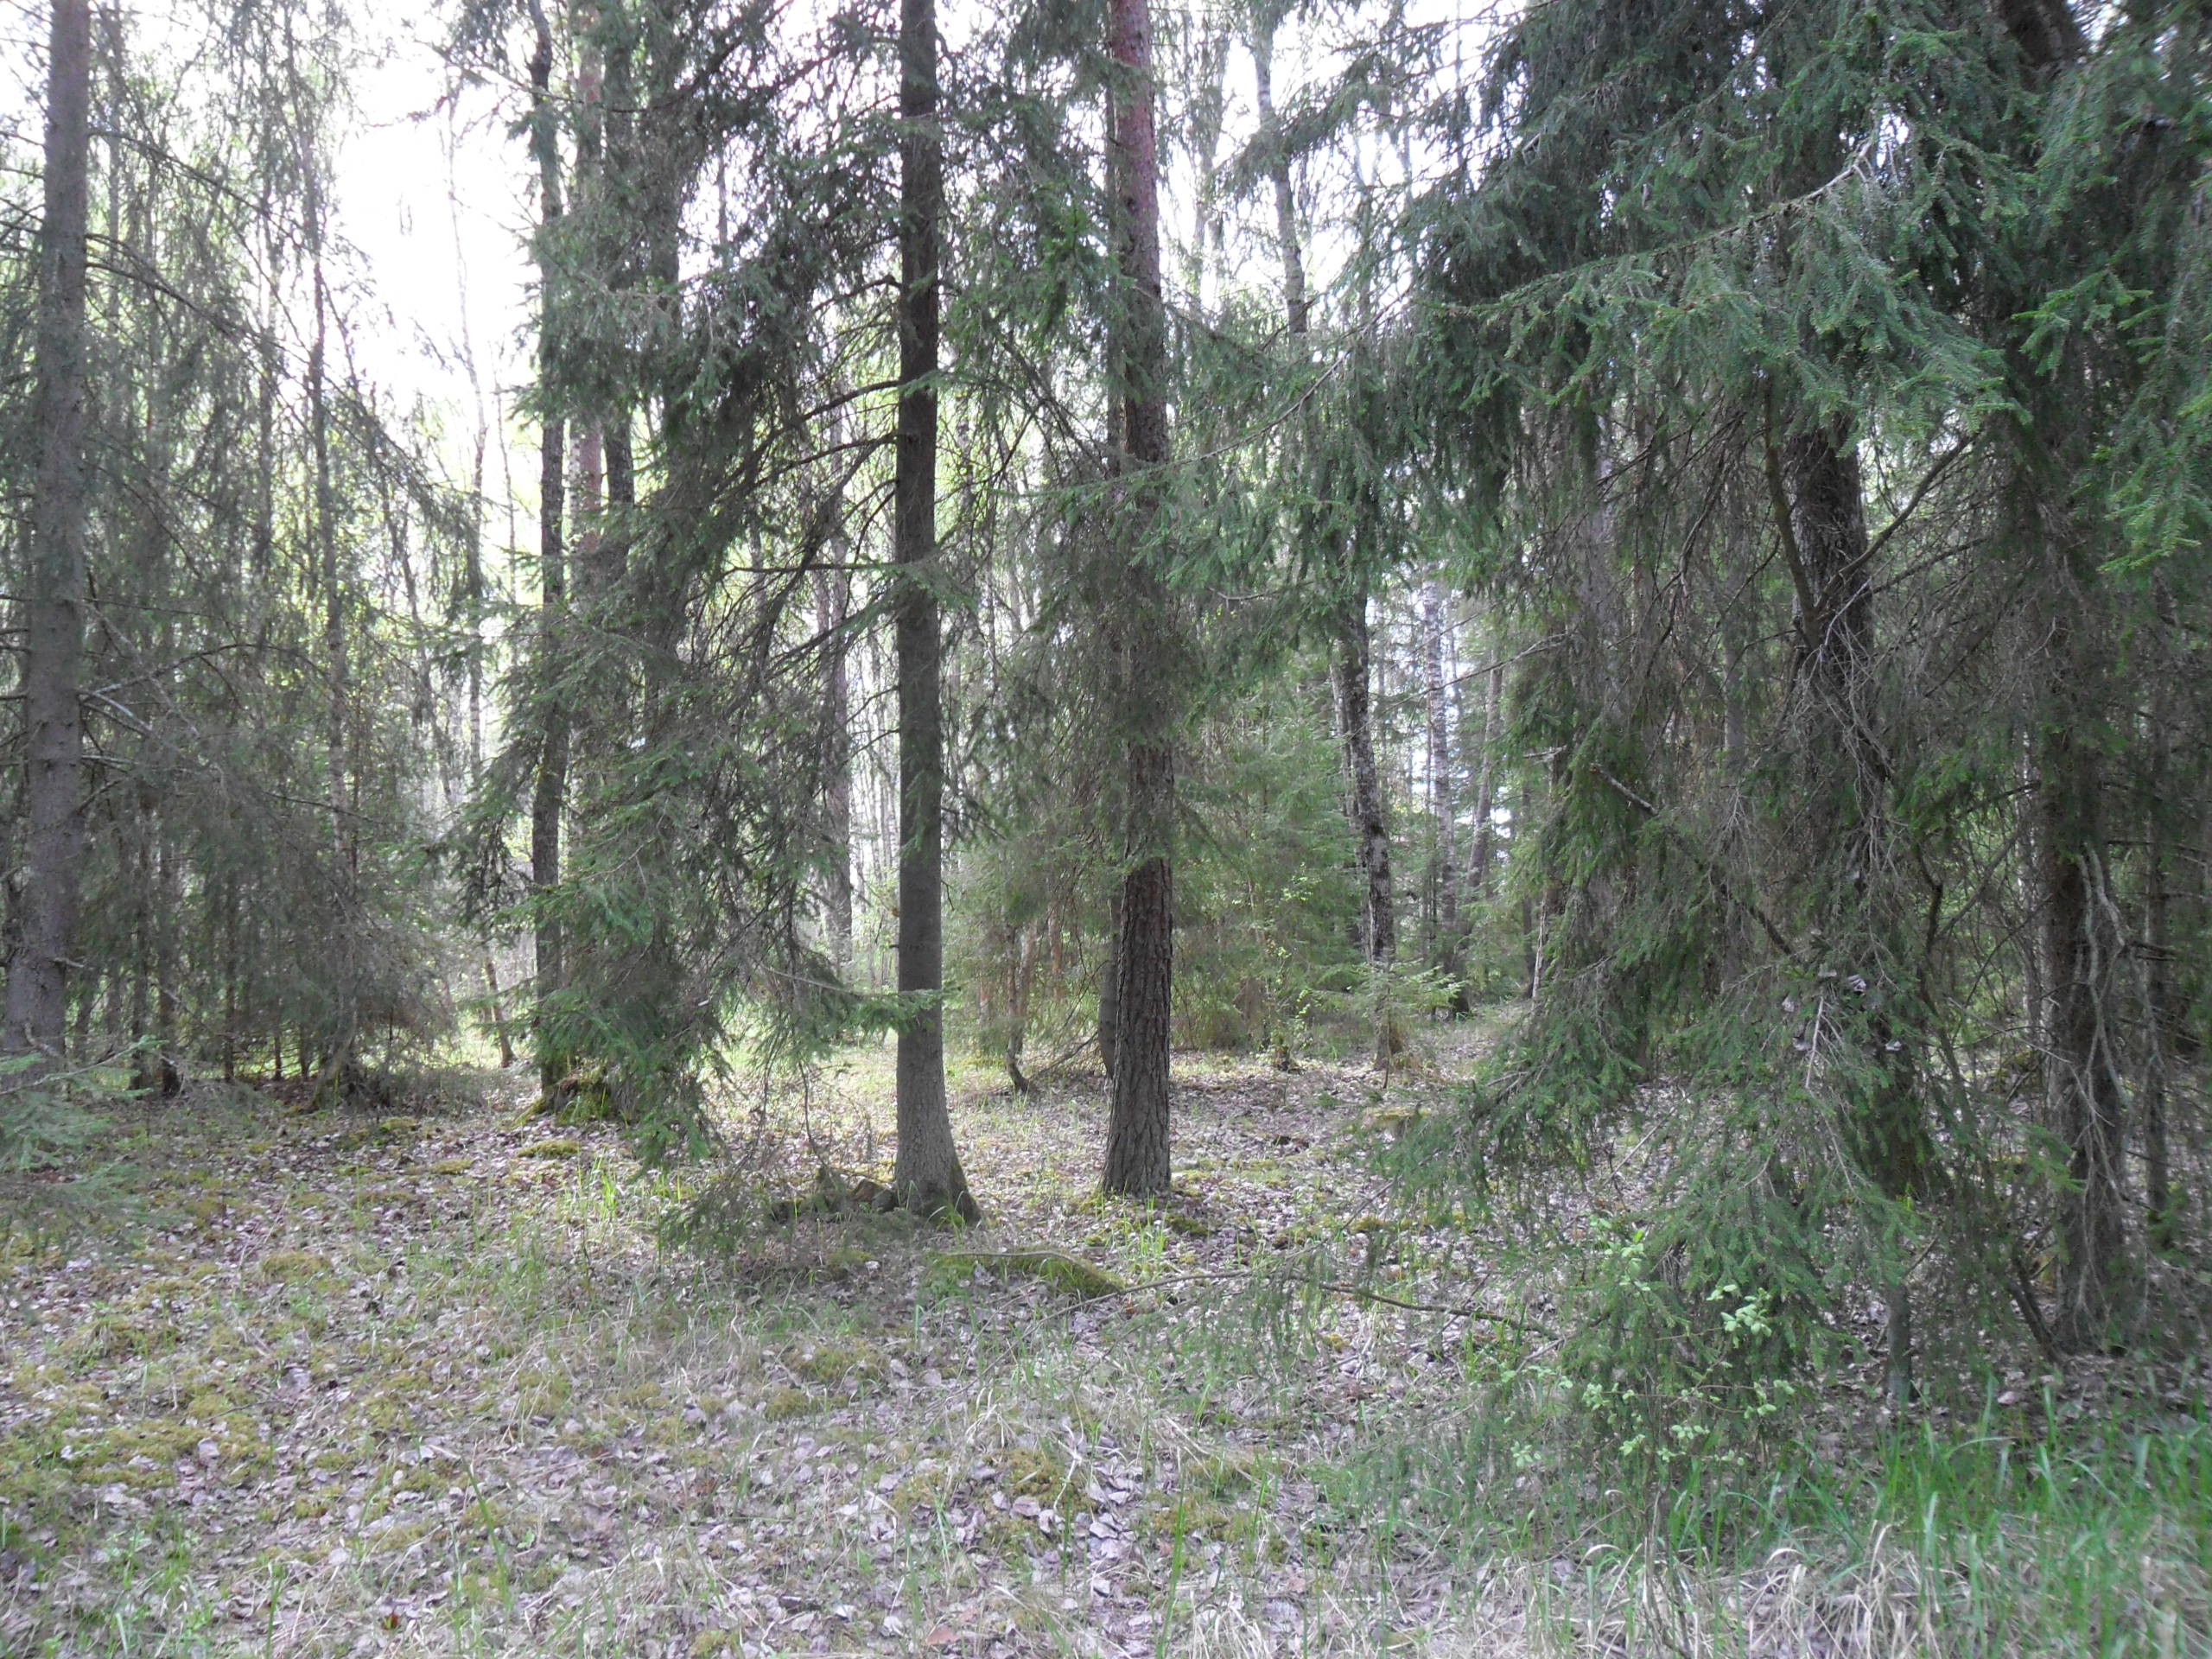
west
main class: Woodland
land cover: Spruce dominated mixed woodland
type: hemiboreal forest and nemoral coniferous forest and mixed broadleaved-coniferous forest
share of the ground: > 75 %
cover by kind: coniferous forest trees 55 %, broadleaved forest trees 45 %
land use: Forestry
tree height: > 5 m
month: May
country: LV
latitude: 57.2519
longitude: 23.0413
